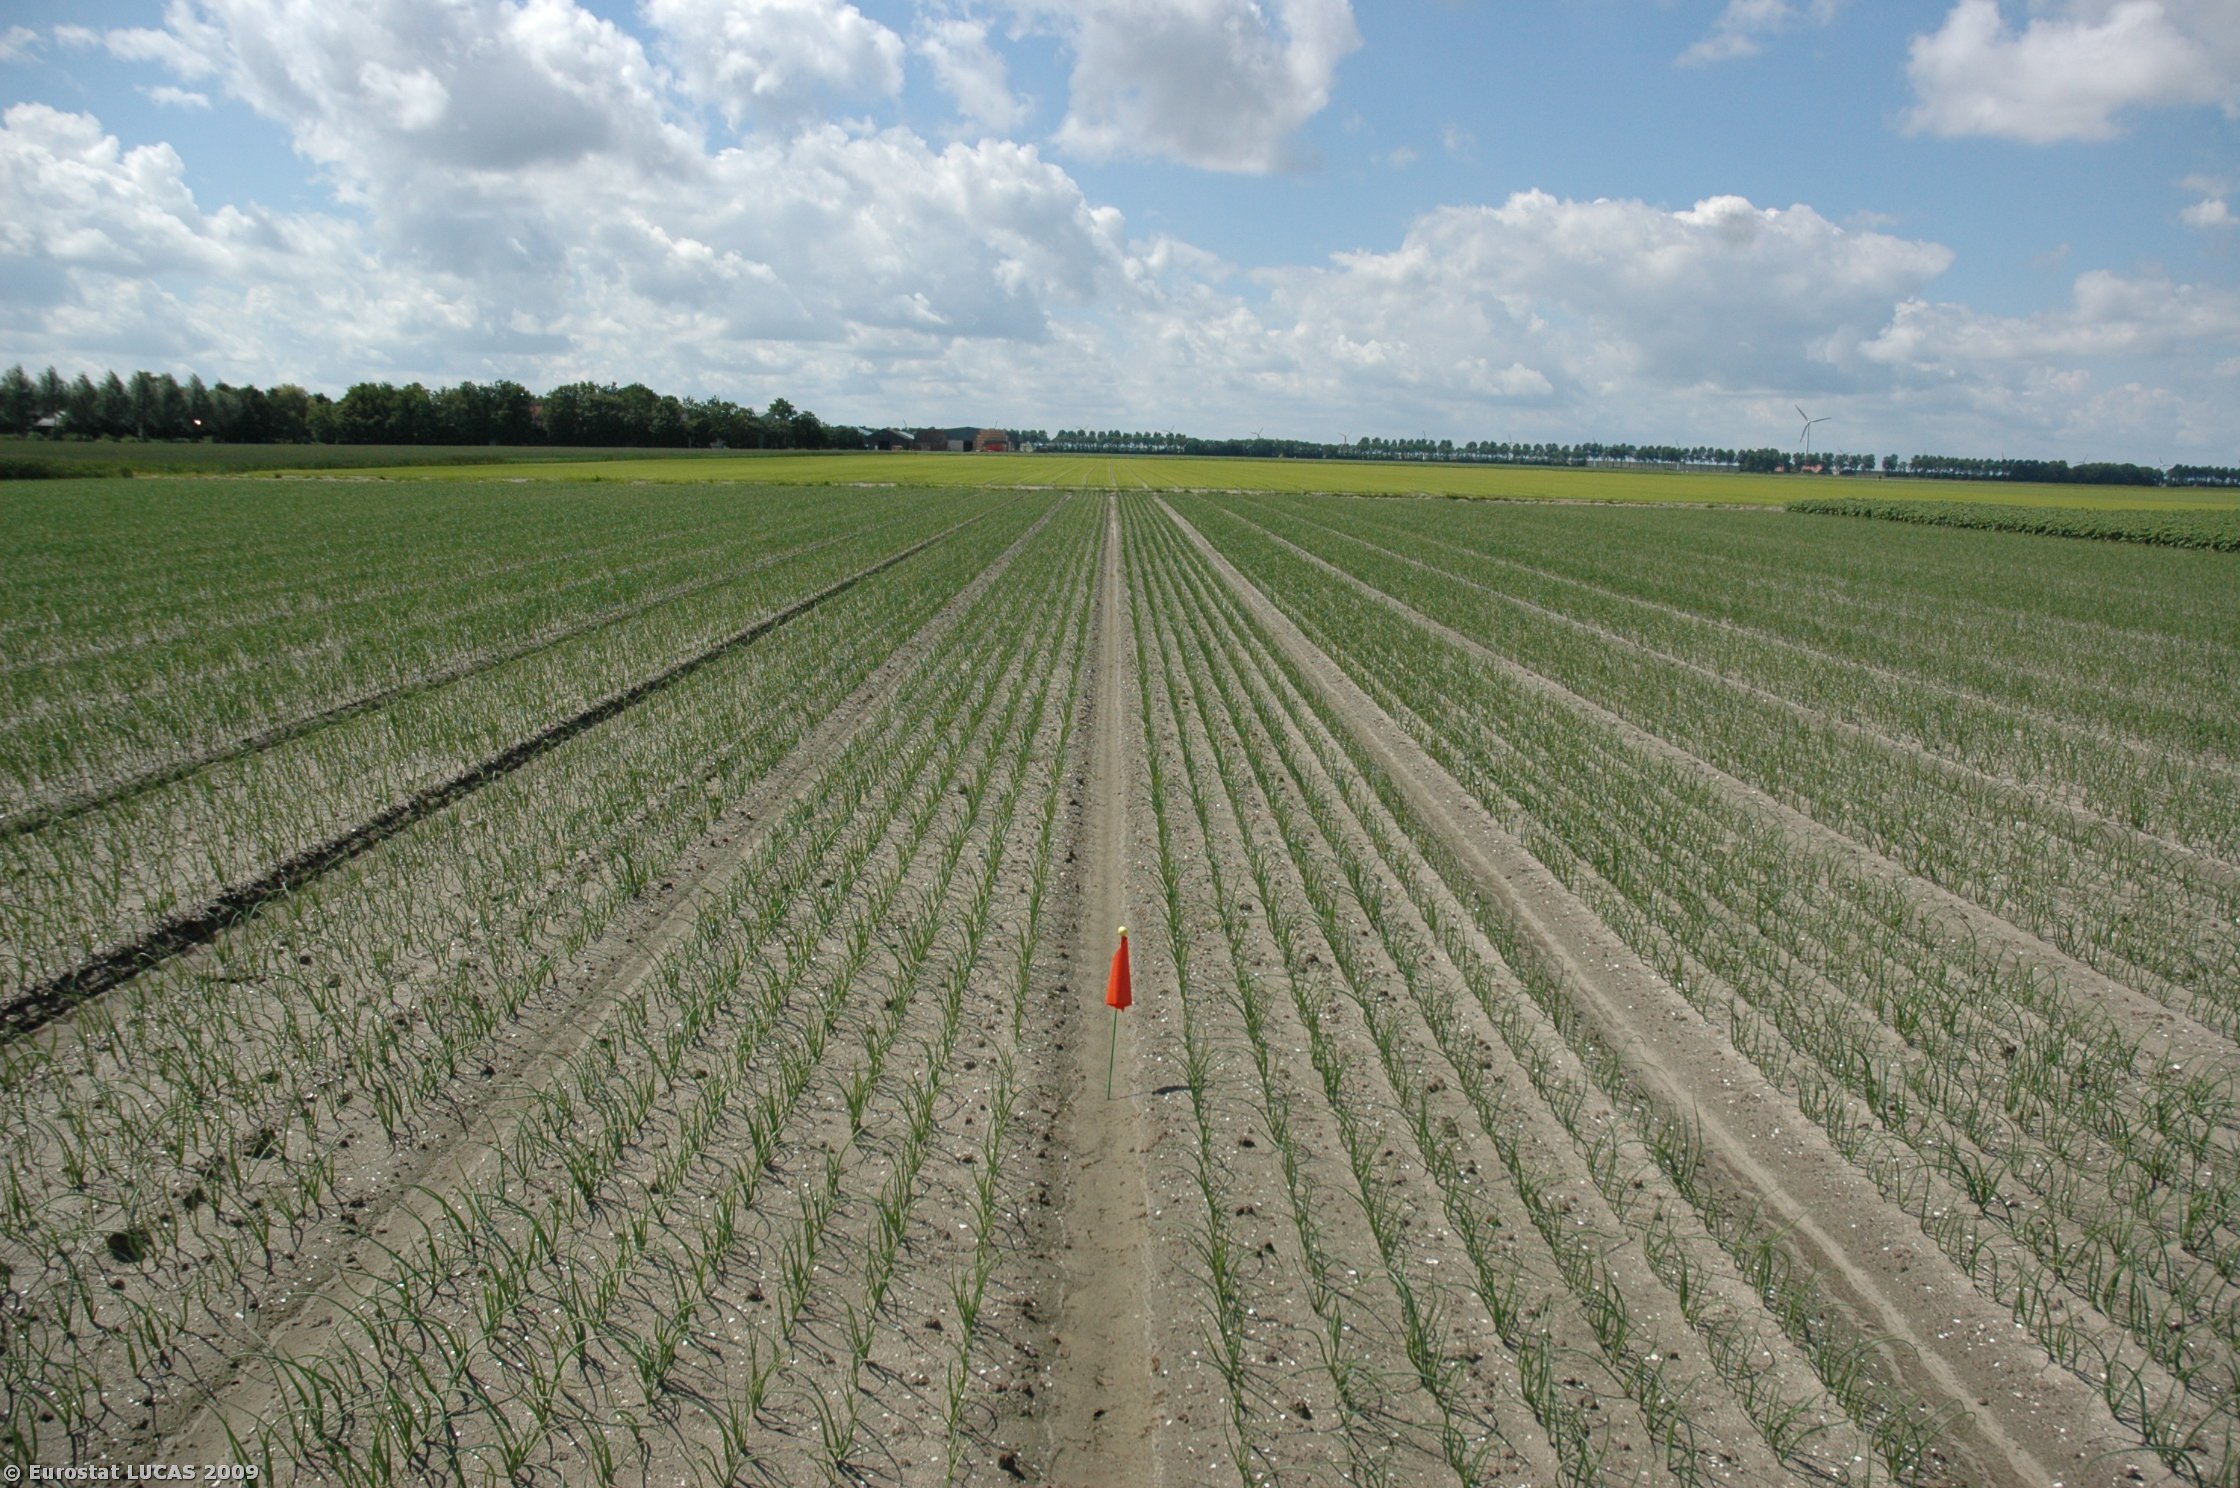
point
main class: Cropland
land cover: Other fresh vegetables
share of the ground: > 75 %
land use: Agriculture (excluding fallow land and kitchen gardens)
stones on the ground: < 10 %
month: June
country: NL
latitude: 52.7112
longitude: 5.6322
